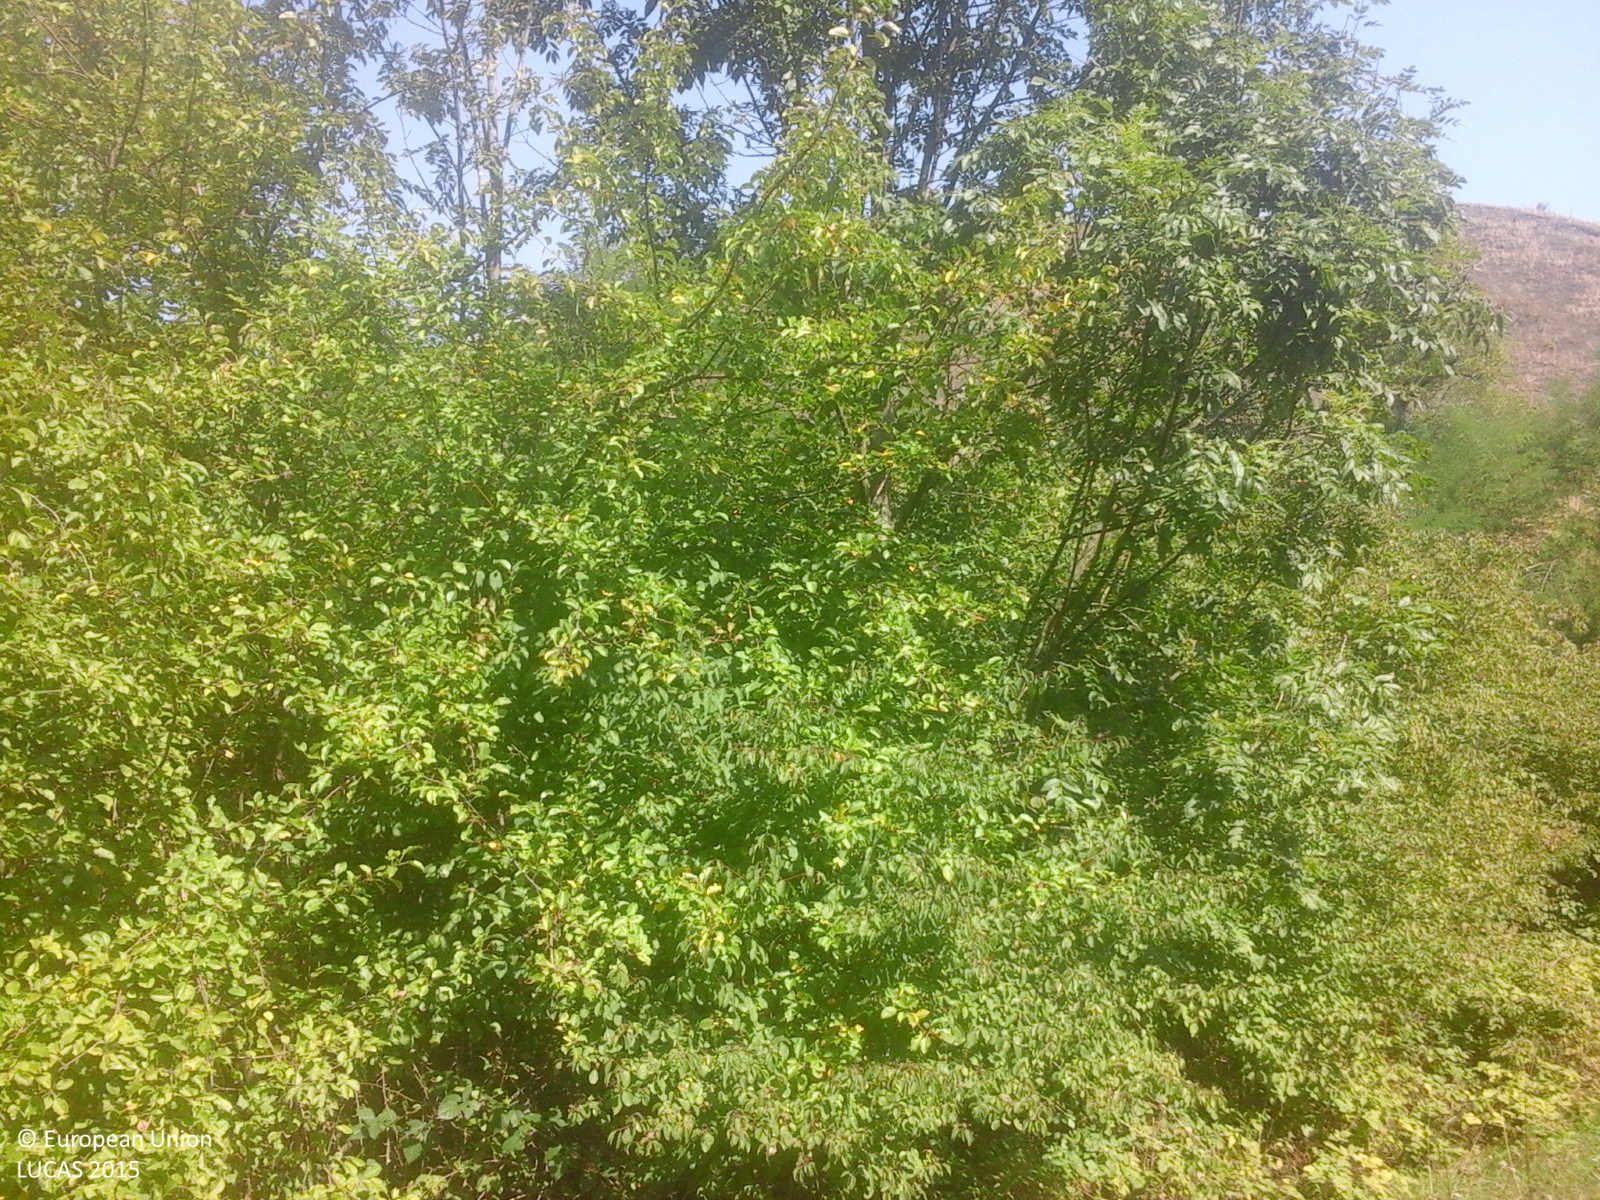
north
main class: Cropland
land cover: Other fruit trees and berries
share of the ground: > 75 %
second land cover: Grassland without tree/shrub cover
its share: > 75 %
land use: Agriculture (excluding fallow land and kitchen gardens)
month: August
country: RO
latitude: 46.1324
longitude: 22.4351
